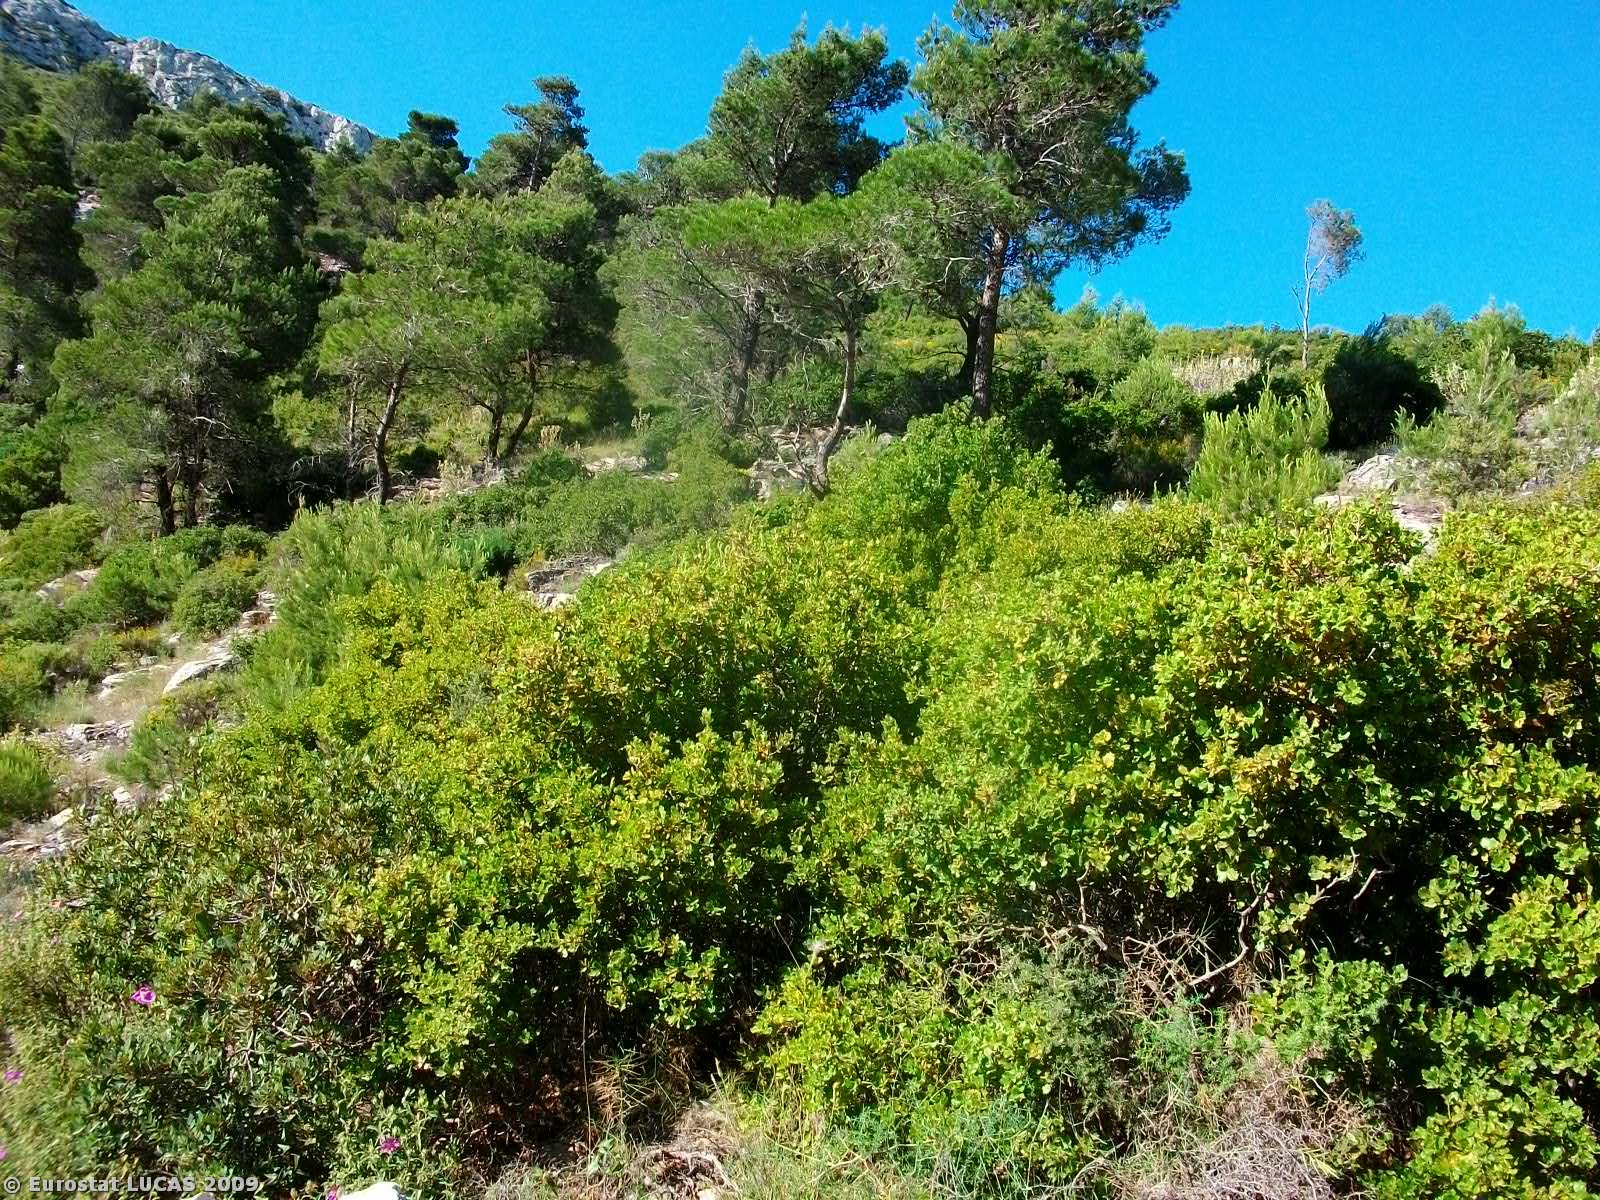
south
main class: Woodland
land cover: Coniferous woodland
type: coniferous forest of the mediterranean region
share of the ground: 50 - 75 %
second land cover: Shrubland with sparse tree cover
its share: 25 - 50 %
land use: Forestry
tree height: > 5 m
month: May
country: GR
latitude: 37.9292
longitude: 23.8036
